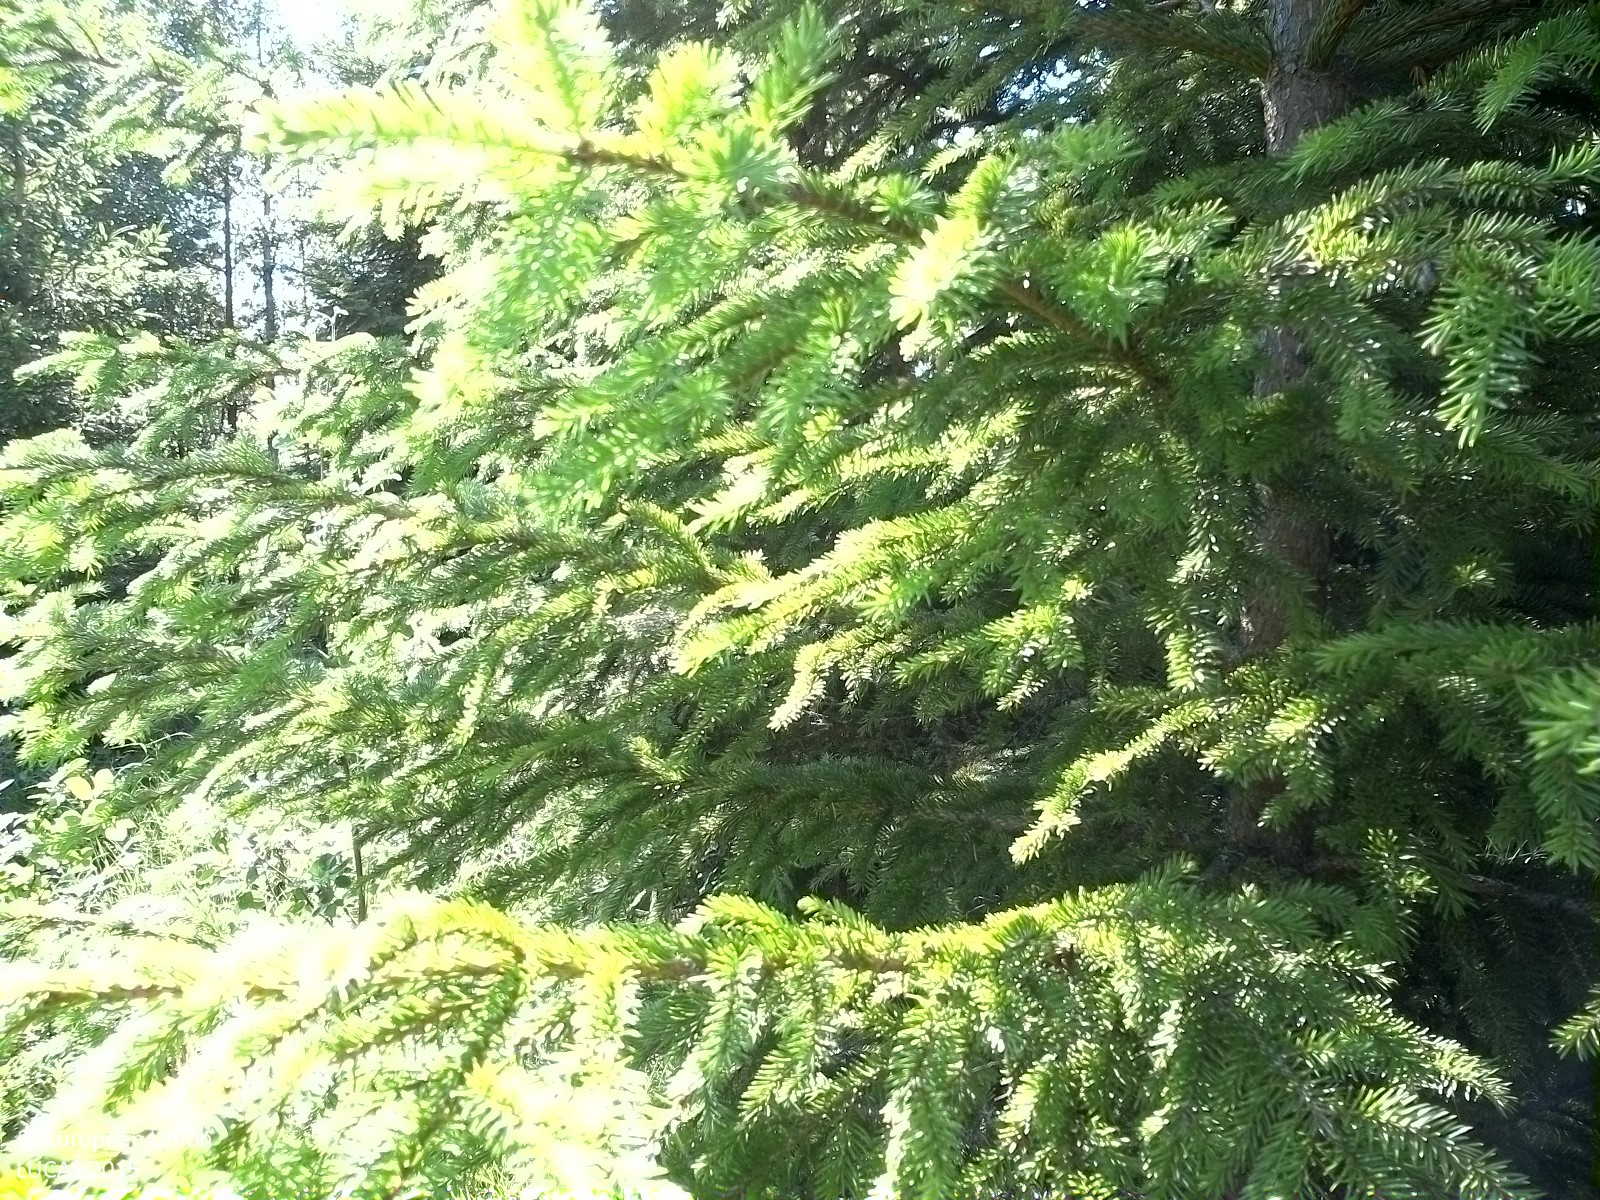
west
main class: Woodland
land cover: Spruce dominated coniferous woodland
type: boreal forest
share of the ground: 25 - 50 %
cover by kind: herbaceous plants 55 %, coniferous forest trees 45 %
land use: Forestry
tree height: > 5 m
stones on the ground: < 10 %
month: July
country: SE
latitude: 62.2177
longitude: 16.9234
